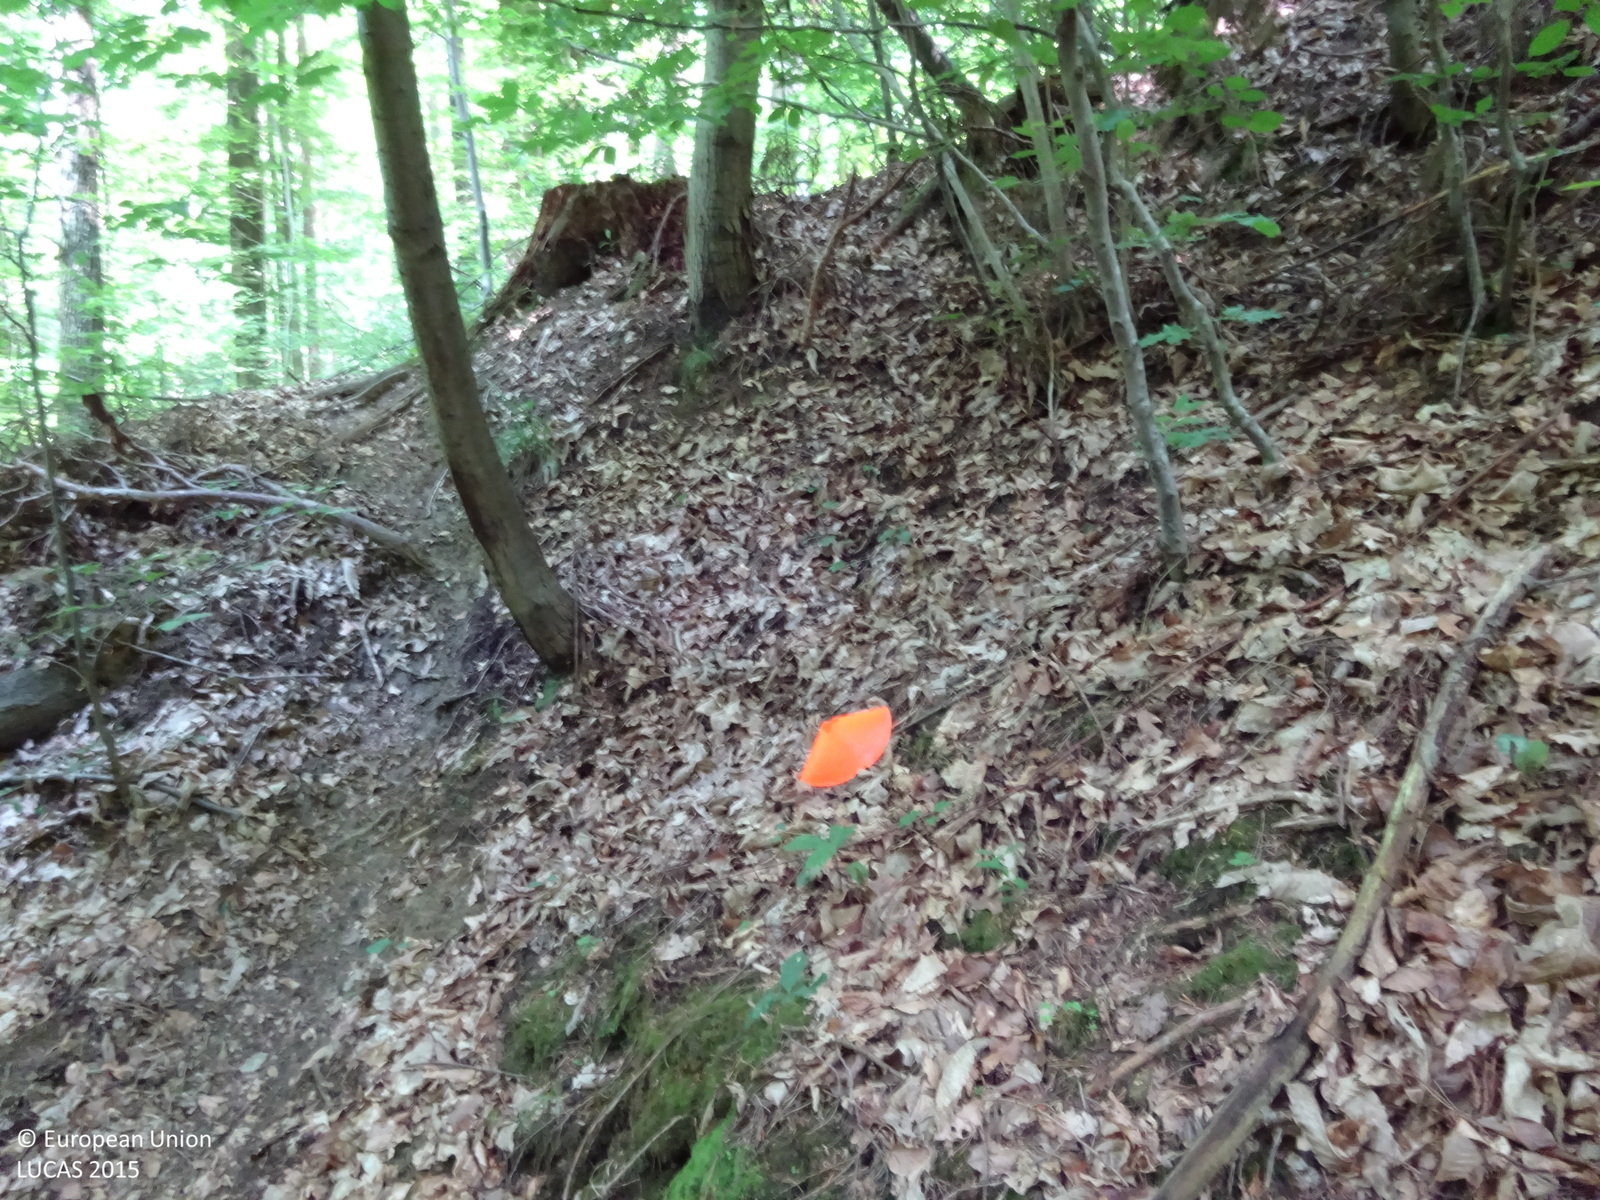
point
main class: Woodland
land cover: Broadleaved woodland
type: mountainous beech forest
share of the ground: > 75 %
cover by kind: broadleaved forest trees 100 %
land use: Forestry
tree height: > 5 m
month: July
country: AT
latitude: 46.8633
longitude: 16.1007
